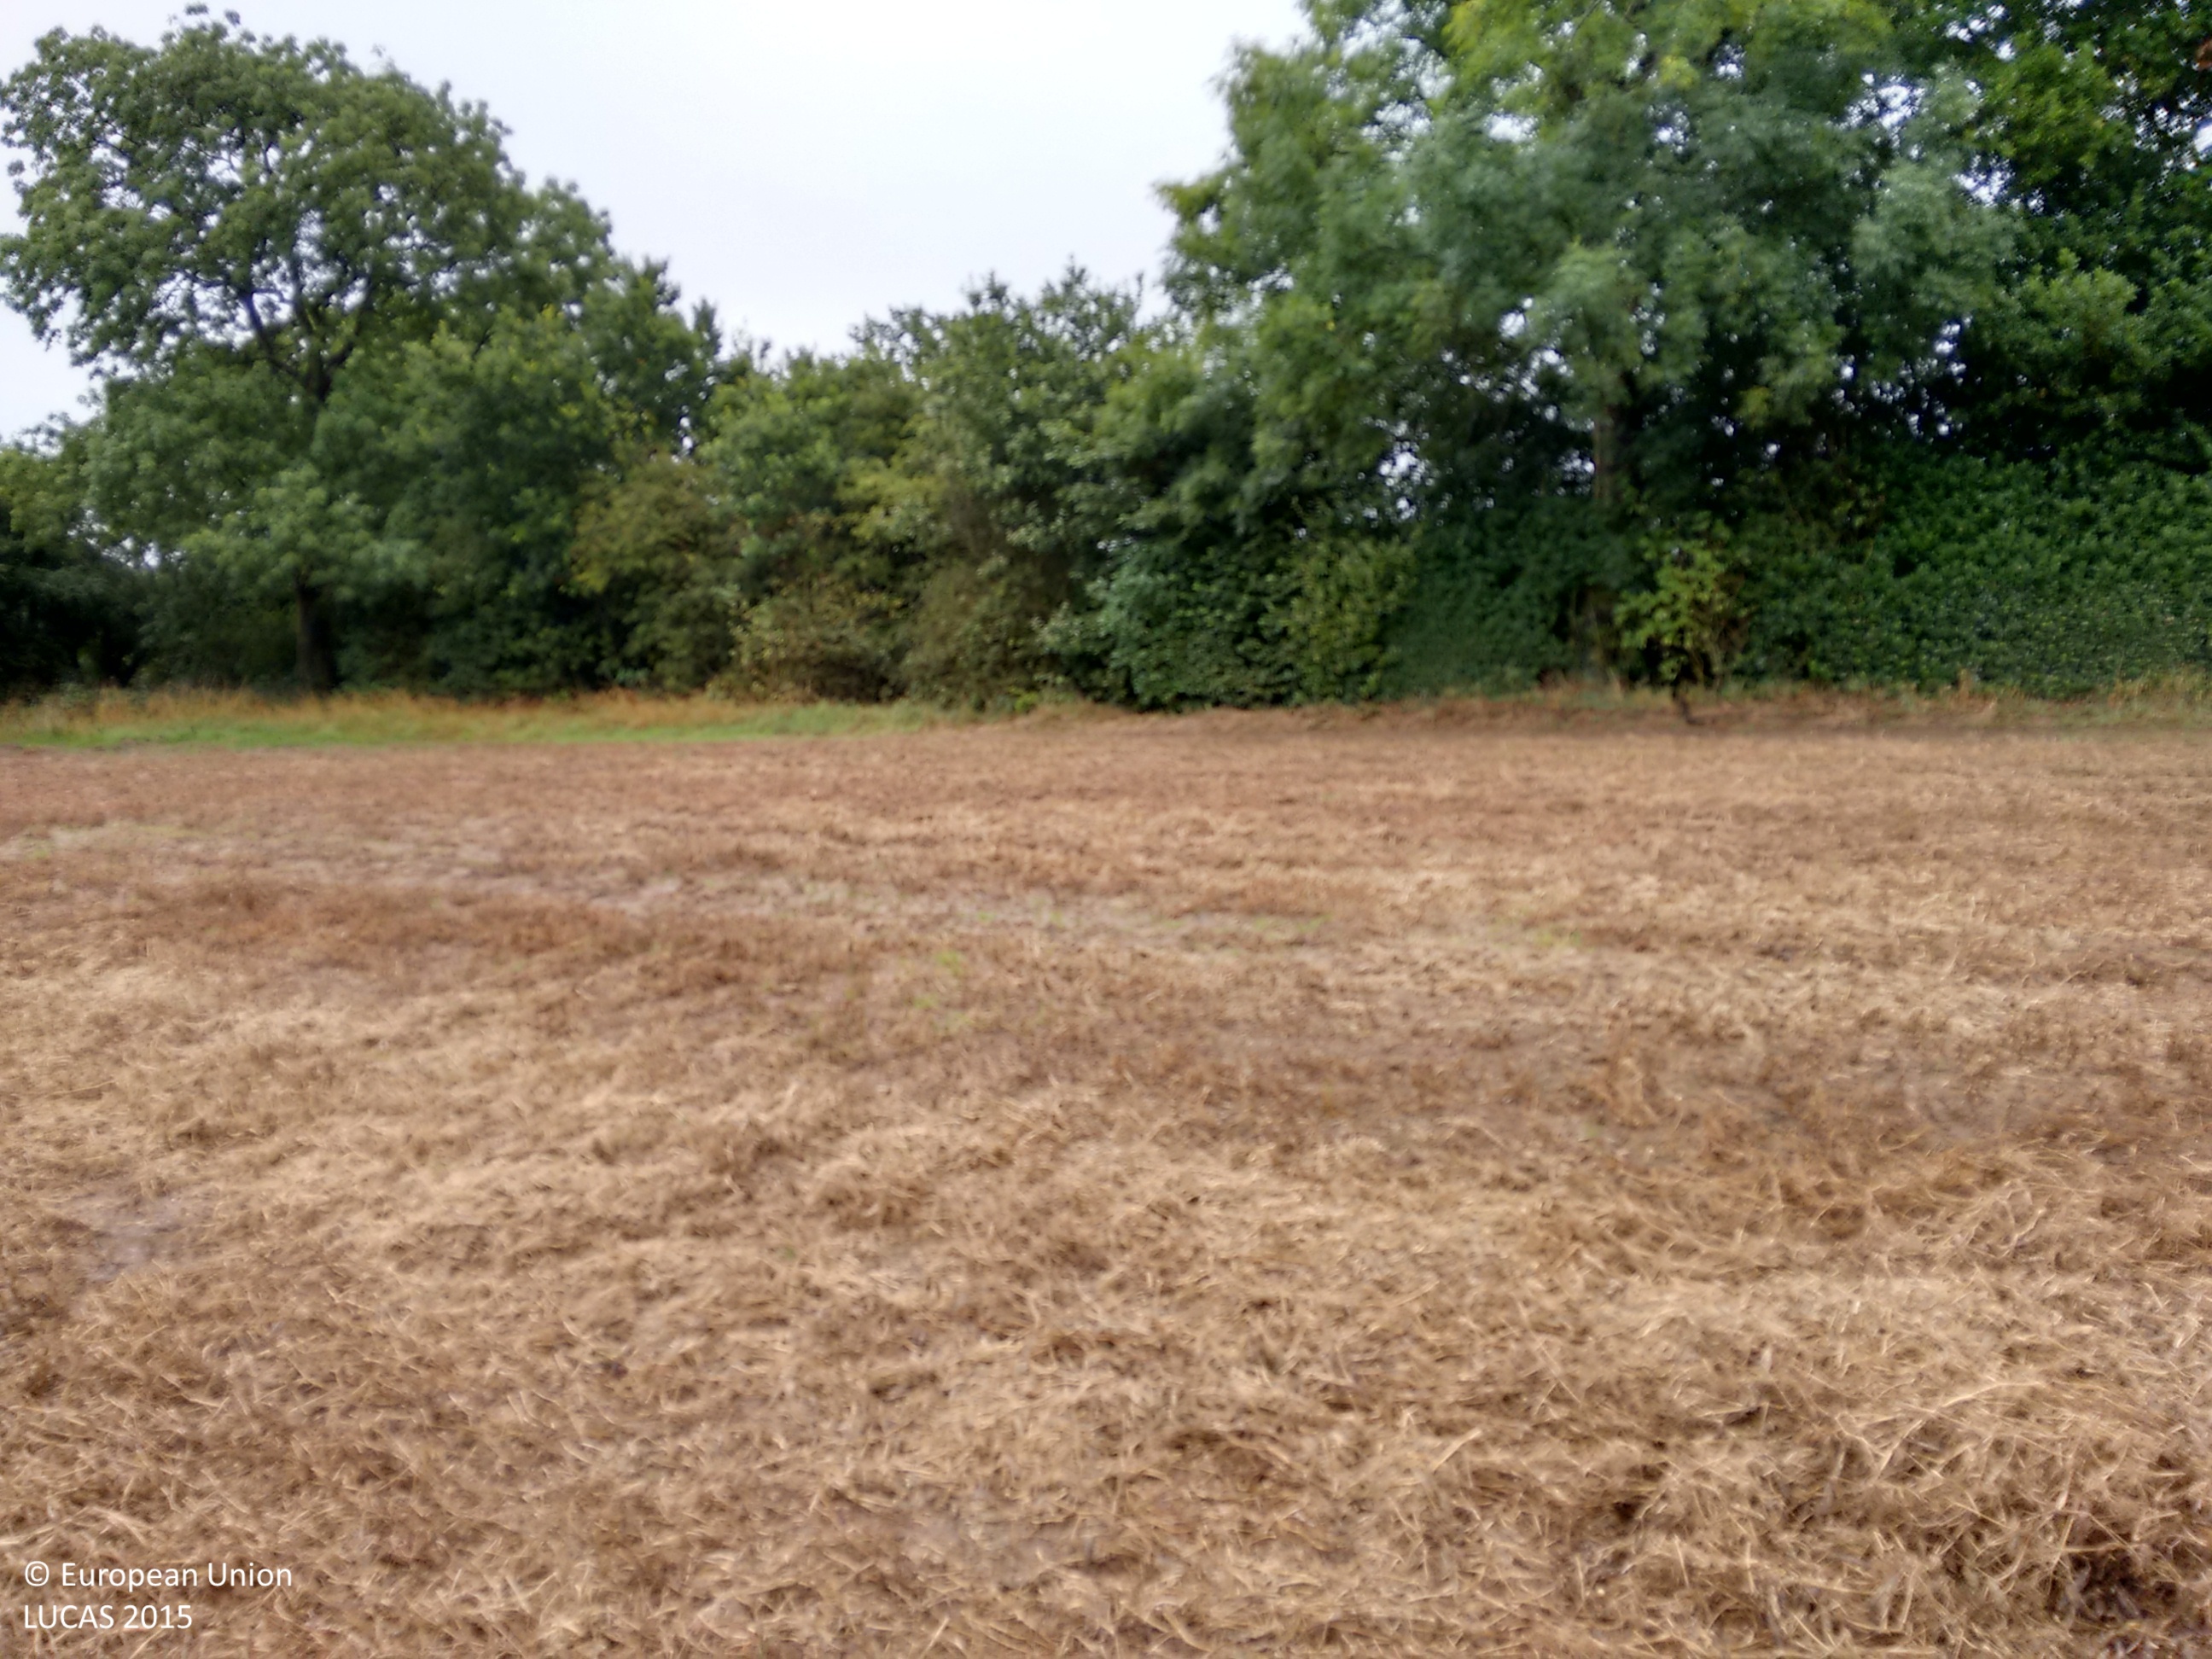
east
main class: Cropland
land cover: Dry pulses
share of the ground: > 75 %
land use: Agriculture (excluding fallow land and kitchen gardens)
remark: Harvested field
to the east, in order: Dry pulses; Broadleaved woodland; Grassland without tree/shrub cover; Ditches and canals; Abandoned hedges; Fences; Grassland without tree/shrub cover
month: September
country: GB
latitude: 52.7662
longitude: -1.4470
